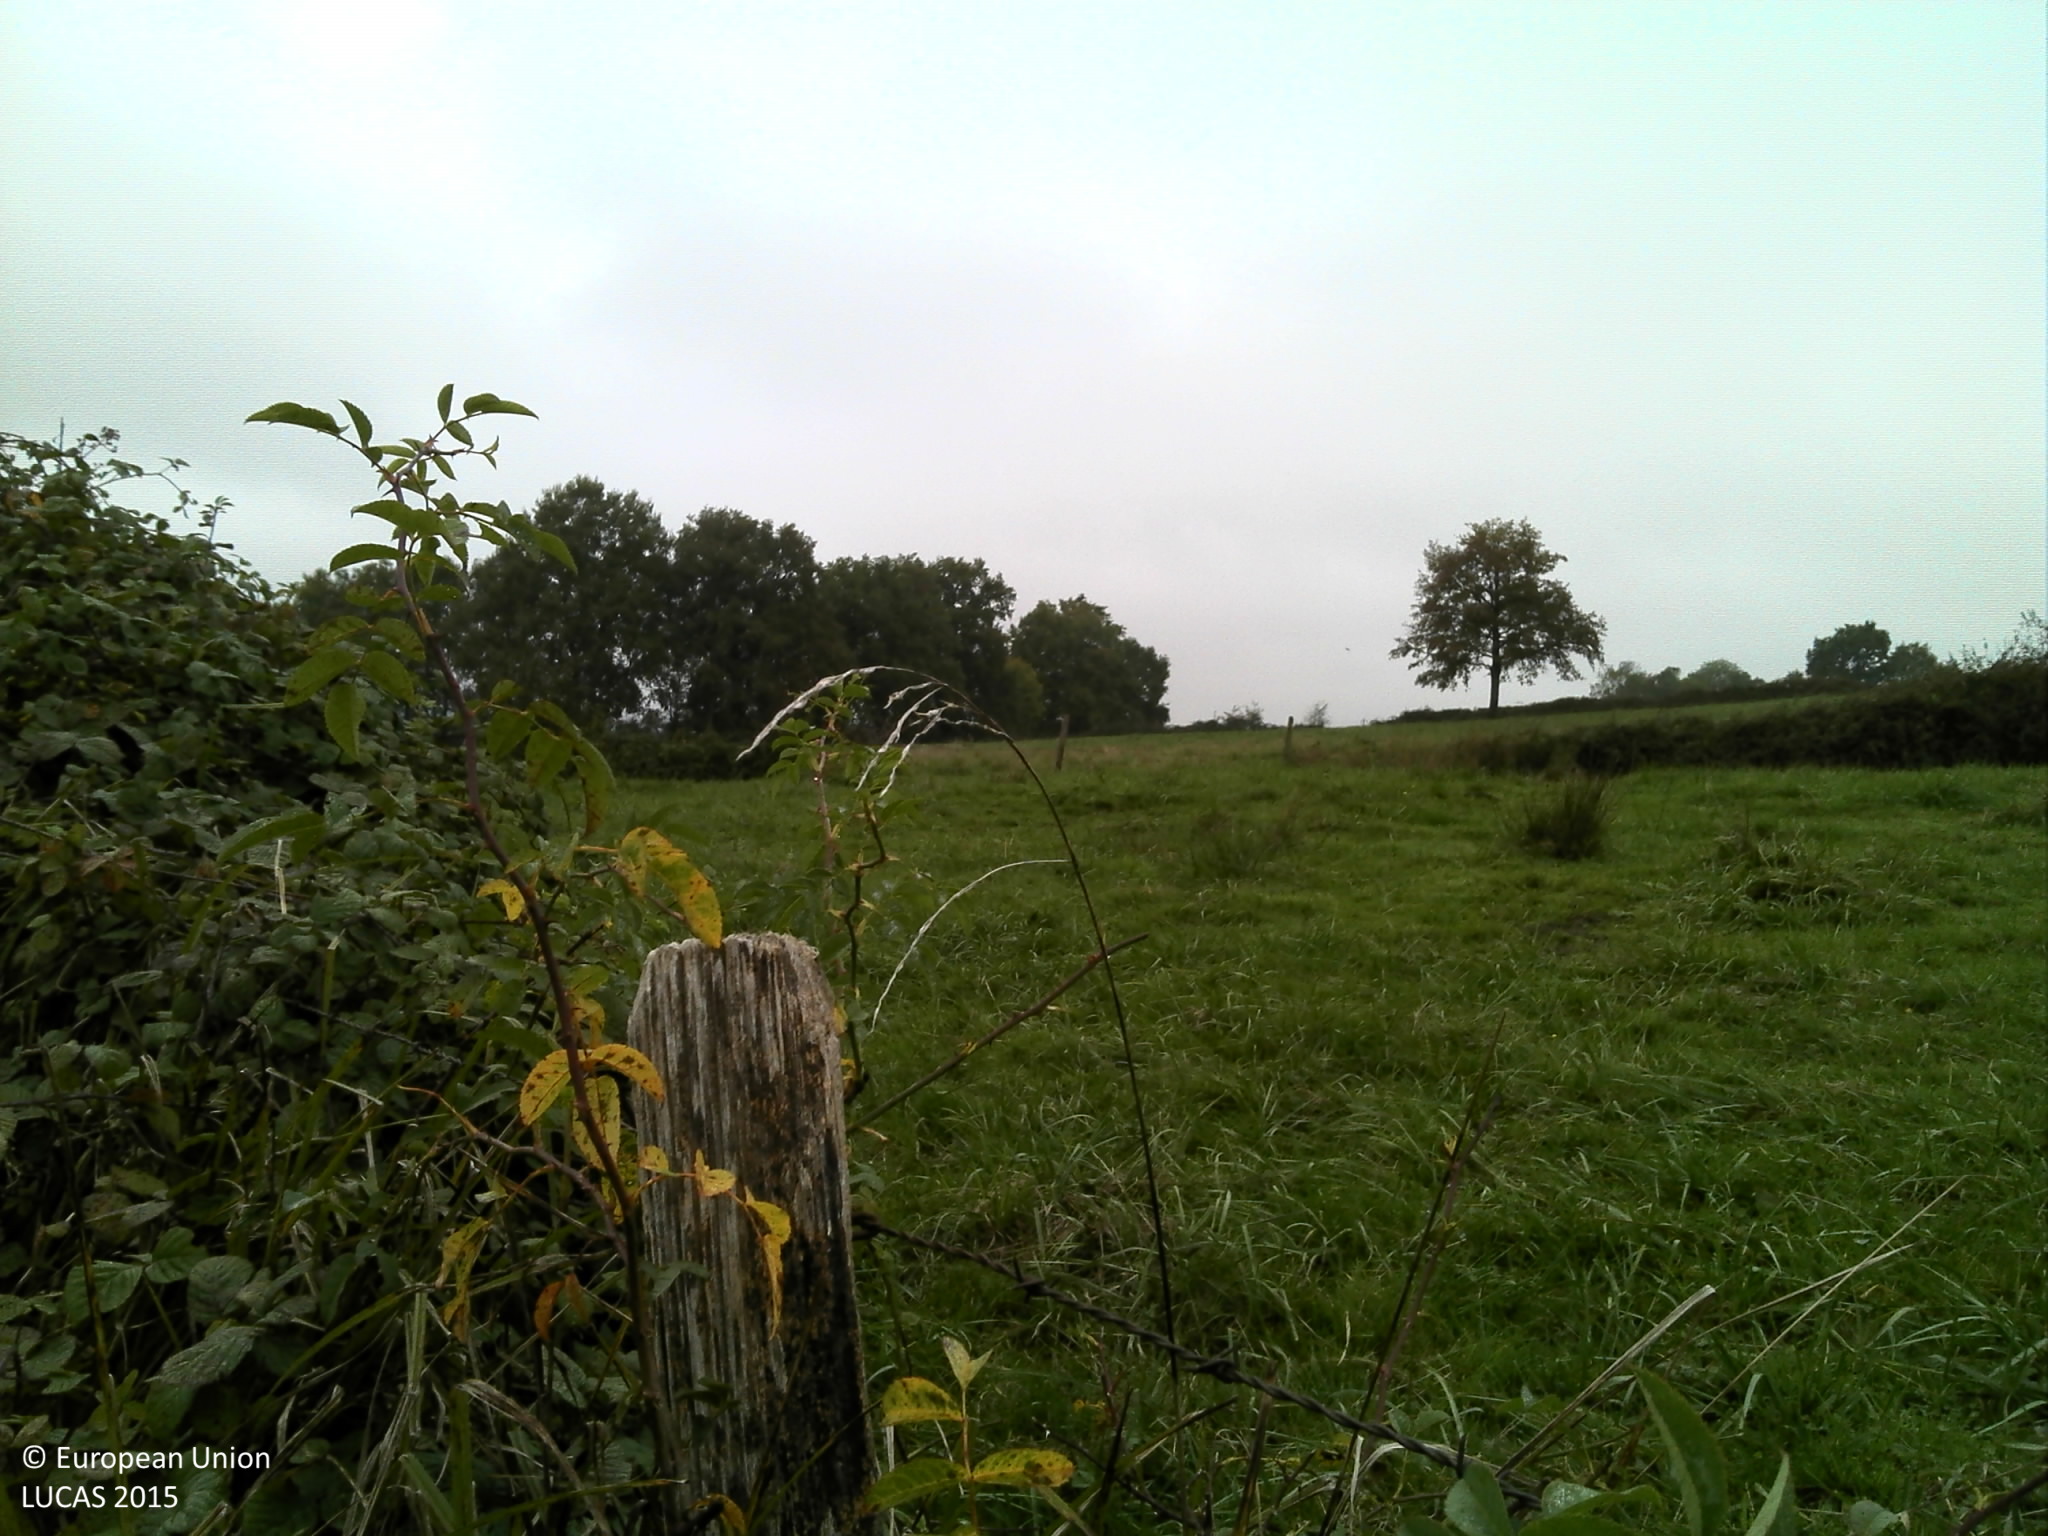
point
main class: Grassland
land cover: Grassland without tree/shrub cover
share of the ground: > 75 %
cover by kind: herbaceous plants 100 %
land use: Agriculture (excluding fallow land and kitchen gardens)
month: October
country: FR
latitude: 46.3746
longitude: 5.3096
